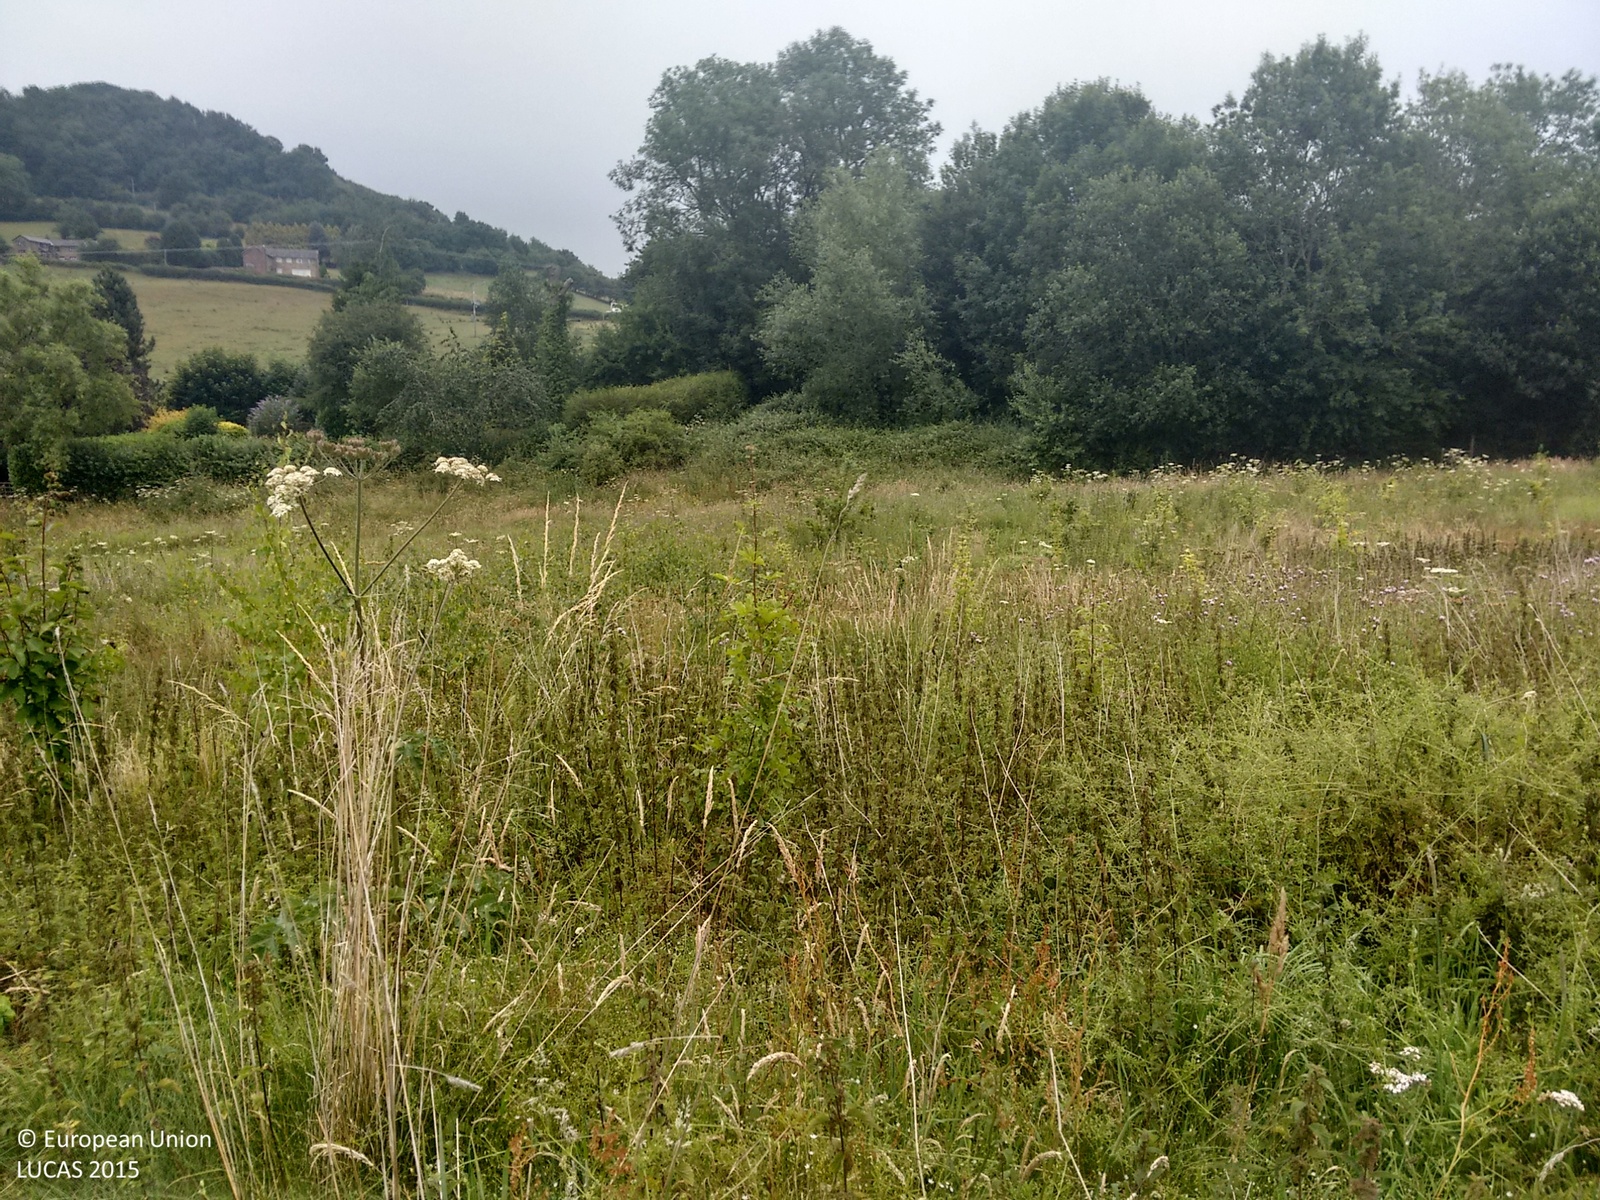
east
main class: Grassland
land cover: Grassland with sparse tree/shrub cover
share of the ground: > 75 %
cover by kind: herbaceous plants 90 %, broadleaved forest trees 5 %, shrubs 5 %
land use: Semi-natural and natural areas not in use
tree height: < 5 m
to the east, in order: Grassland with sparse tree/shrub cover; Grassland without tree/shrub cover; Groves; Fences; Broadleaved woodland; Grass margins; Fences; Tracks; Fences; Broadleaved woodland; Fences; Broadleaved woodland; Conifer hedges; Fences; Grass margins; Paved roads, cycling and walking lanes; Grass margins; Managed hedges; Electric lines; Grassland without tree/shrub cover; Fences; Grassland without tree/shrub cover; Artificial constructions in urban areas
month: July
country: GB
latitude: 52.0192
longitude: -2.7039
